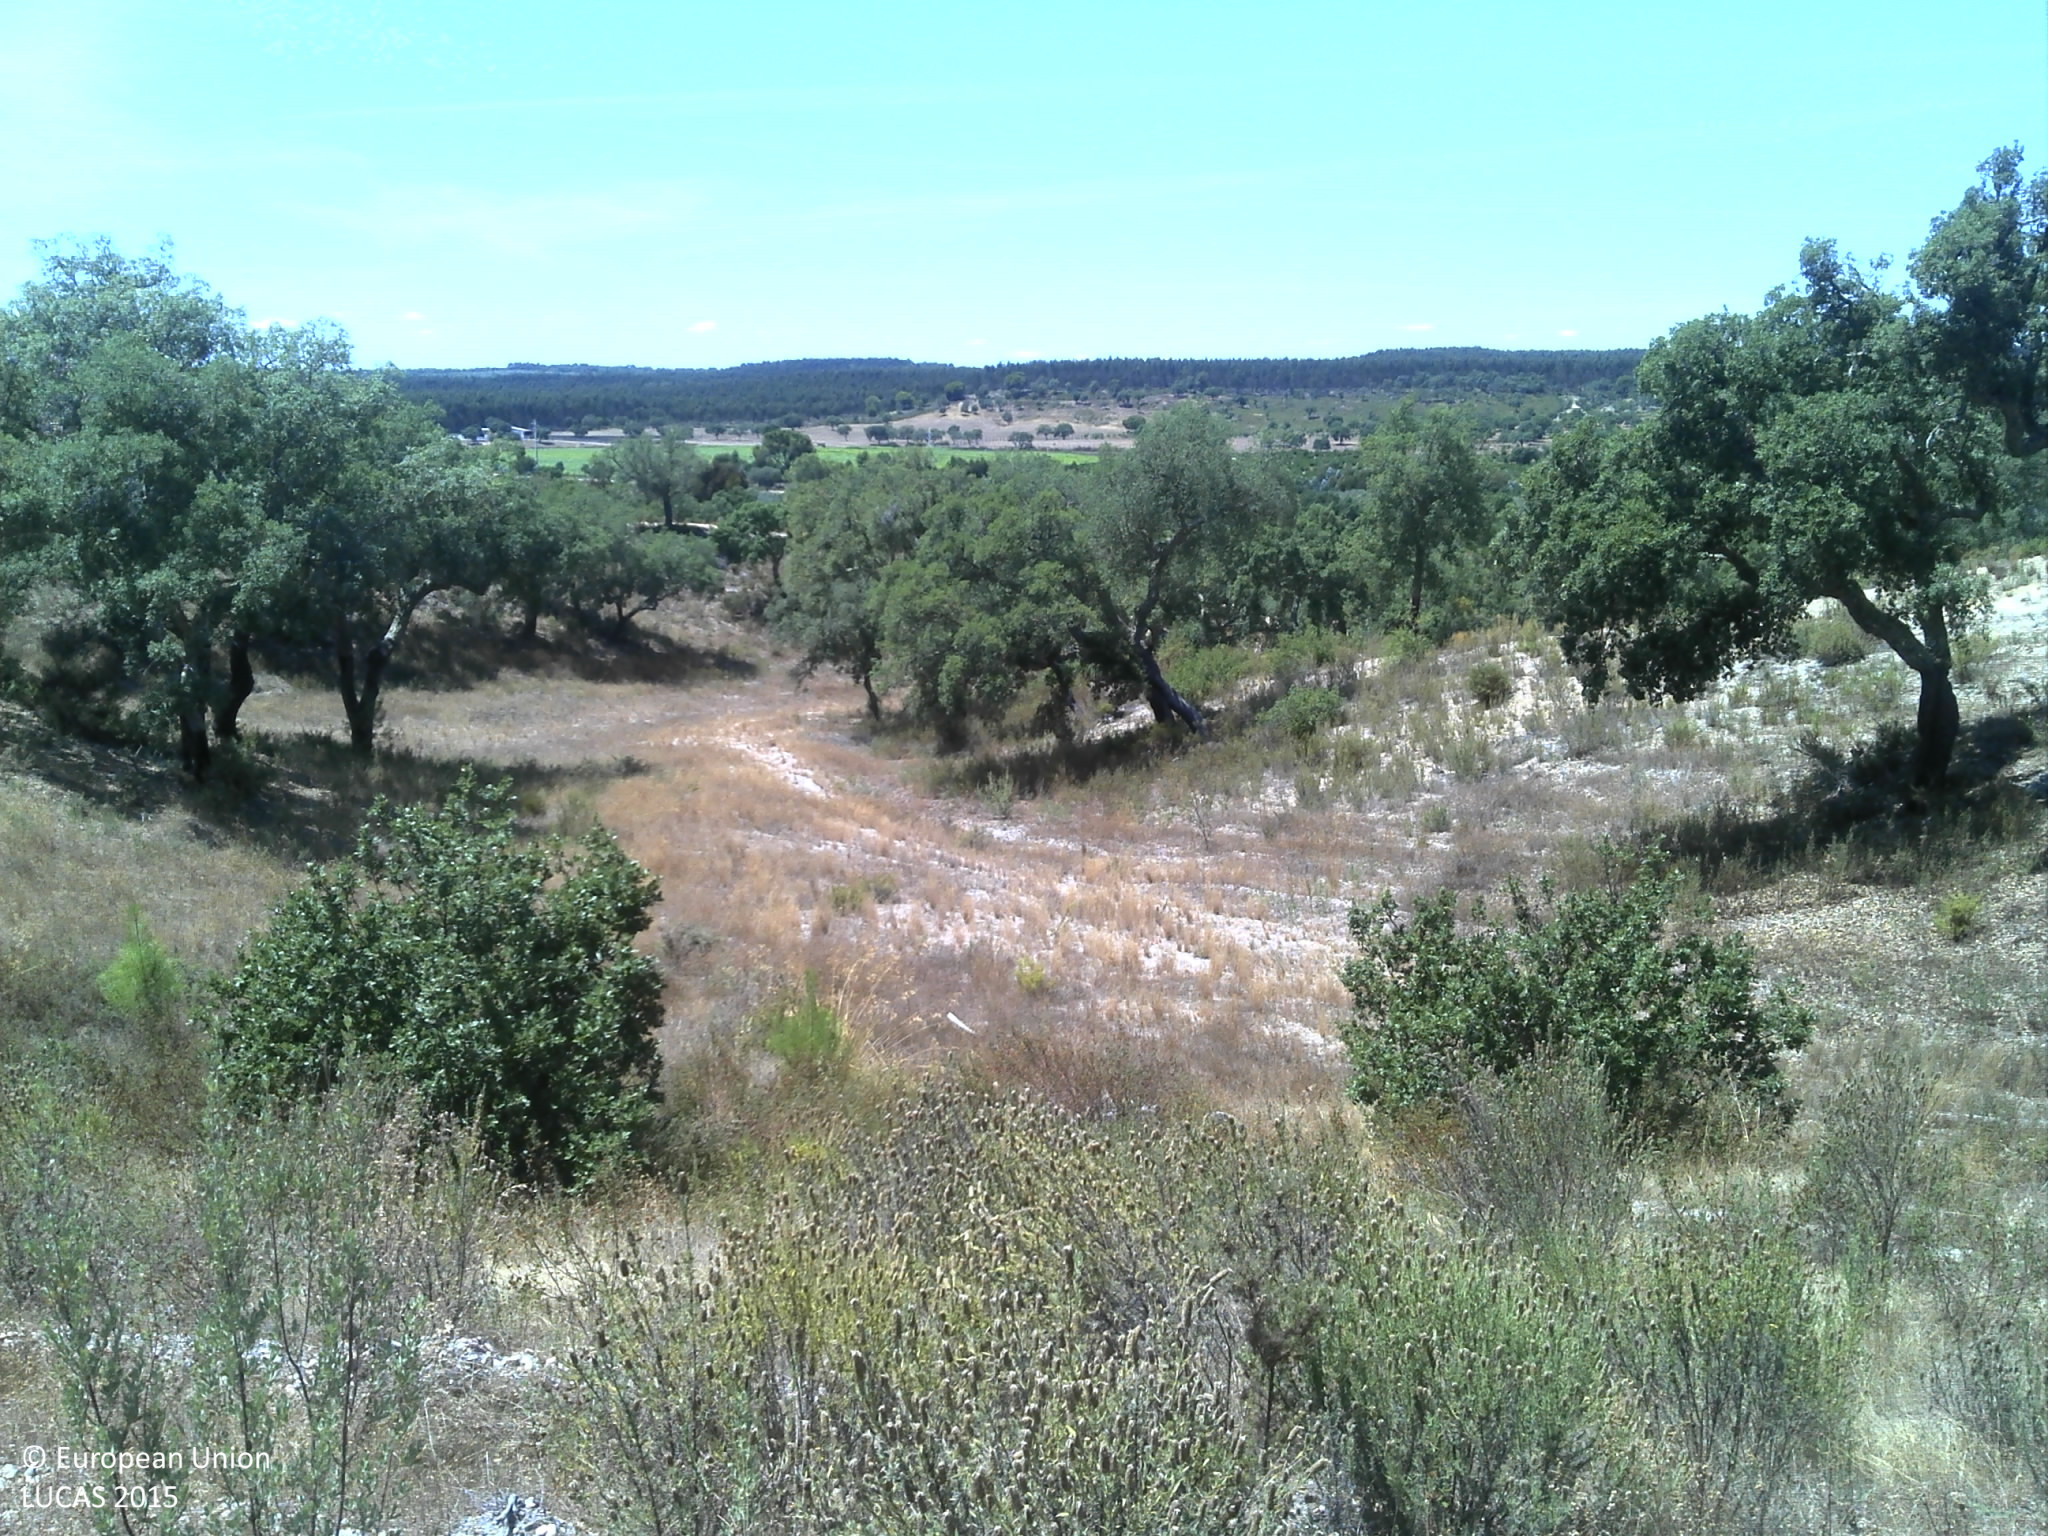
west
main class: Grassland
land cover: Grassland with sparse tree/shrub cover
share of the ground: 25 - 50 %
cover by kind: herbaceous plants 45 %, unconsolidated bare surface 40 %, shrubs 10 %, broadleaved forest trees 5 %
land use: Forestry
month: July
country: PT
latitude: 39.2176
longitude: -8.2801
